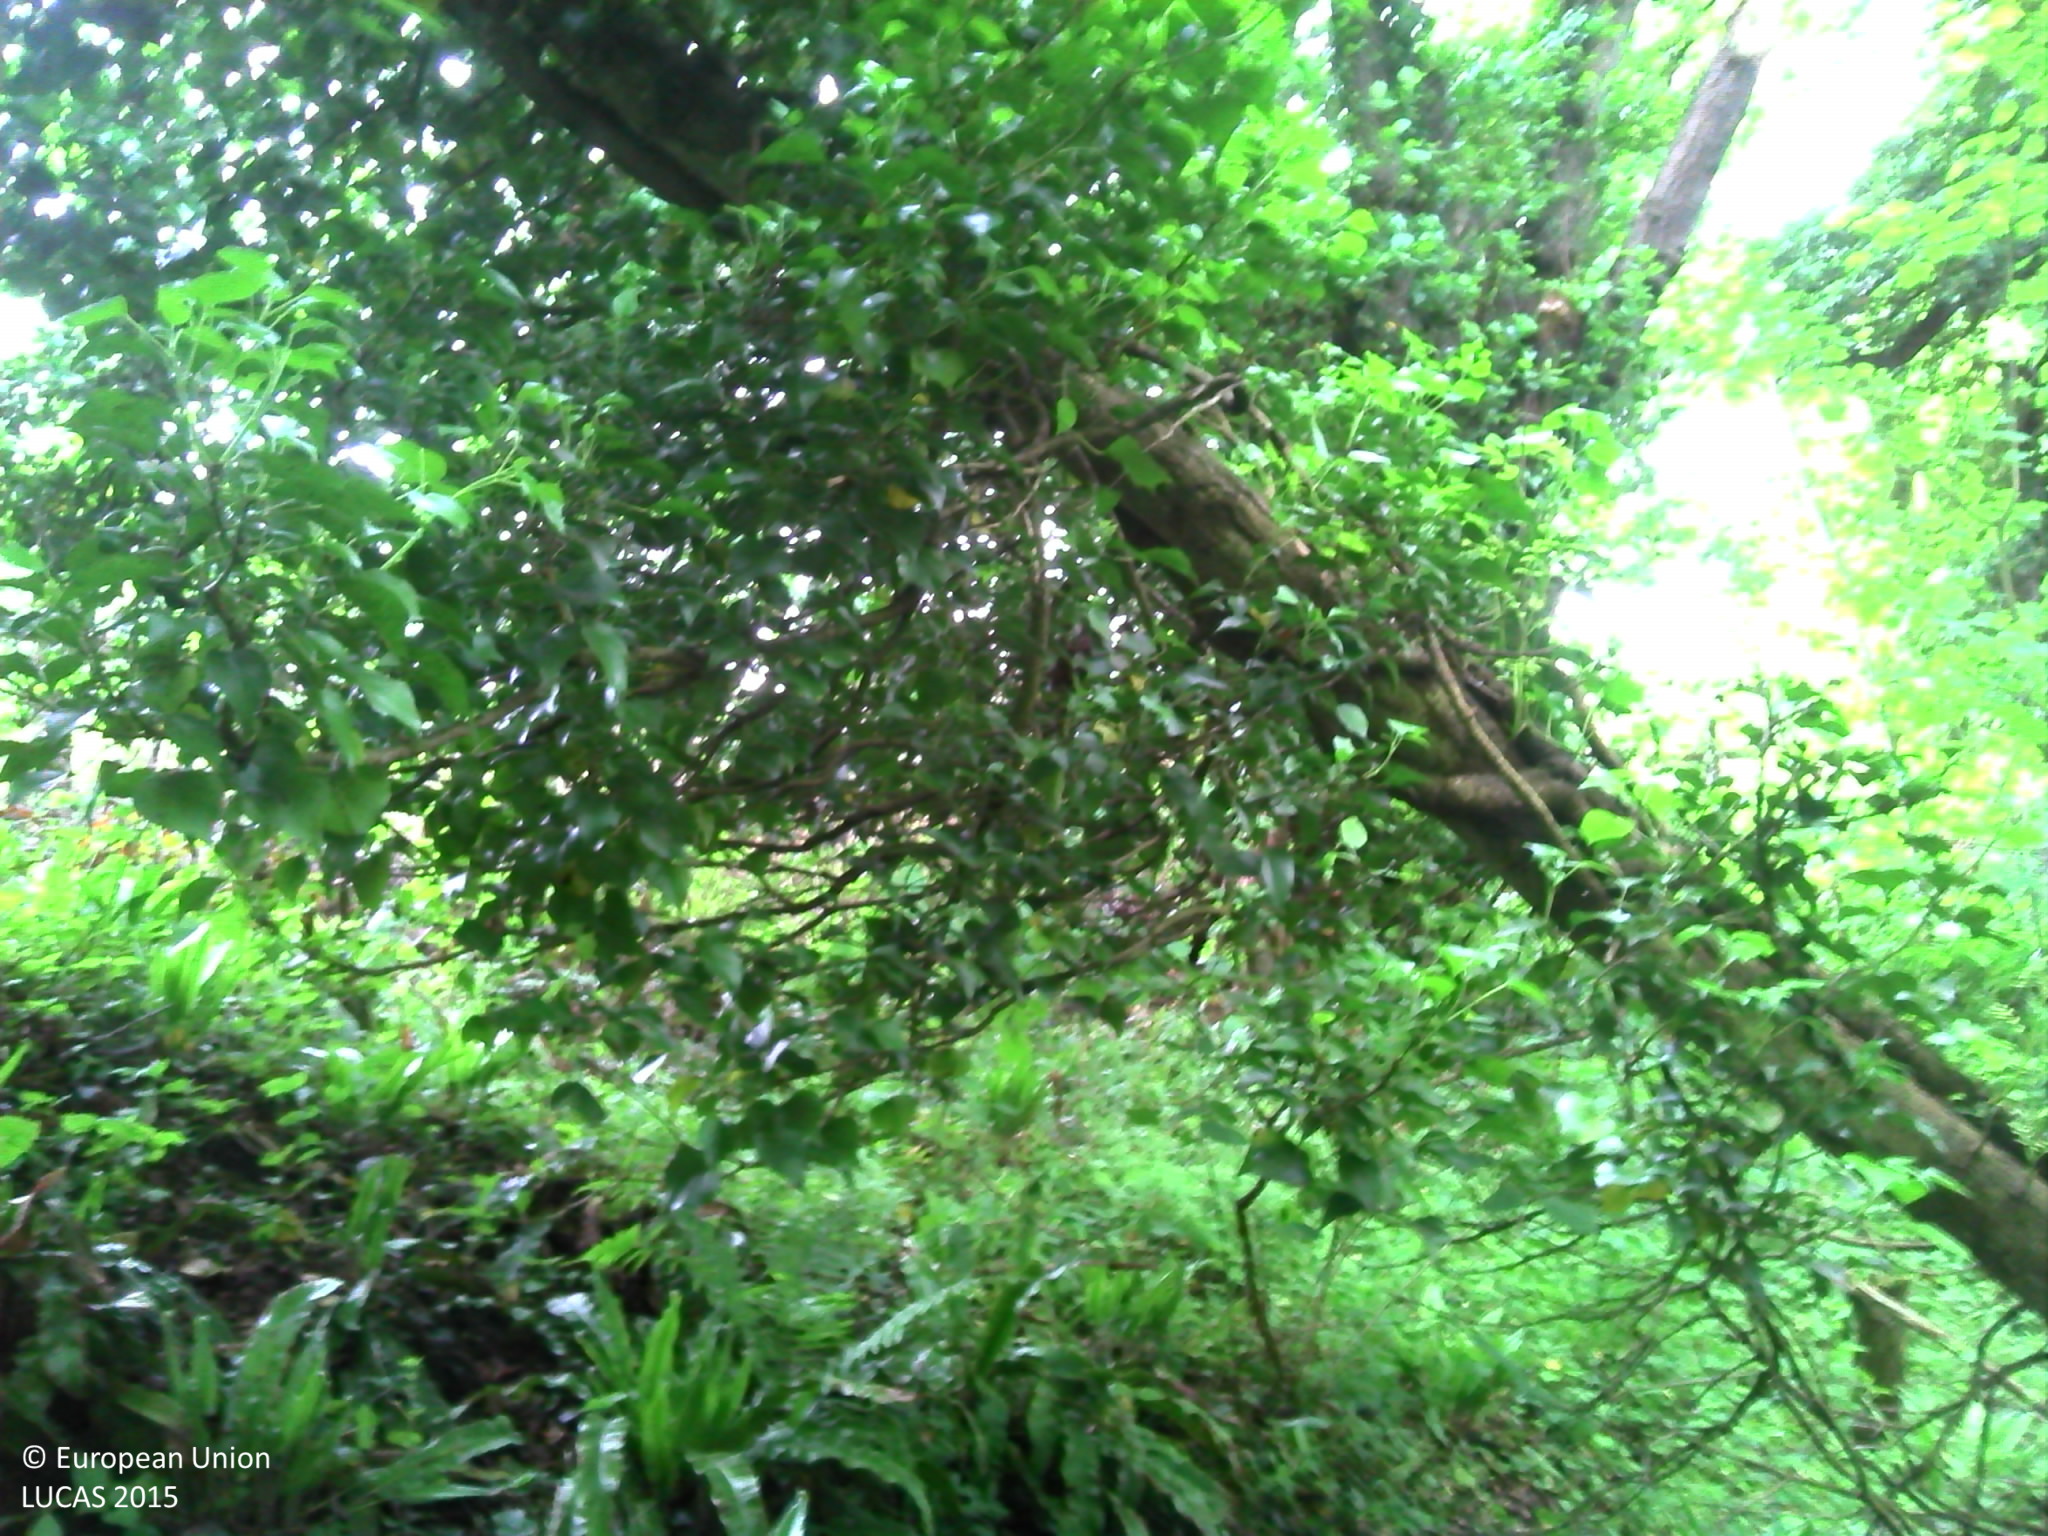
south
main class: Woodland
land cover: Broadleaved woodland
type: mesophytic deciduous forest
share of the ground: > 75 %
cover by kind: broadleaved forest trees 80 %, shrubs 15 %, herbaceous plants 5 %
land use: Semi-natural and natural areas not in use
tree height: > 5 m
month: May
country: FR
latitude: 49.2856
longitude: -0.0539
